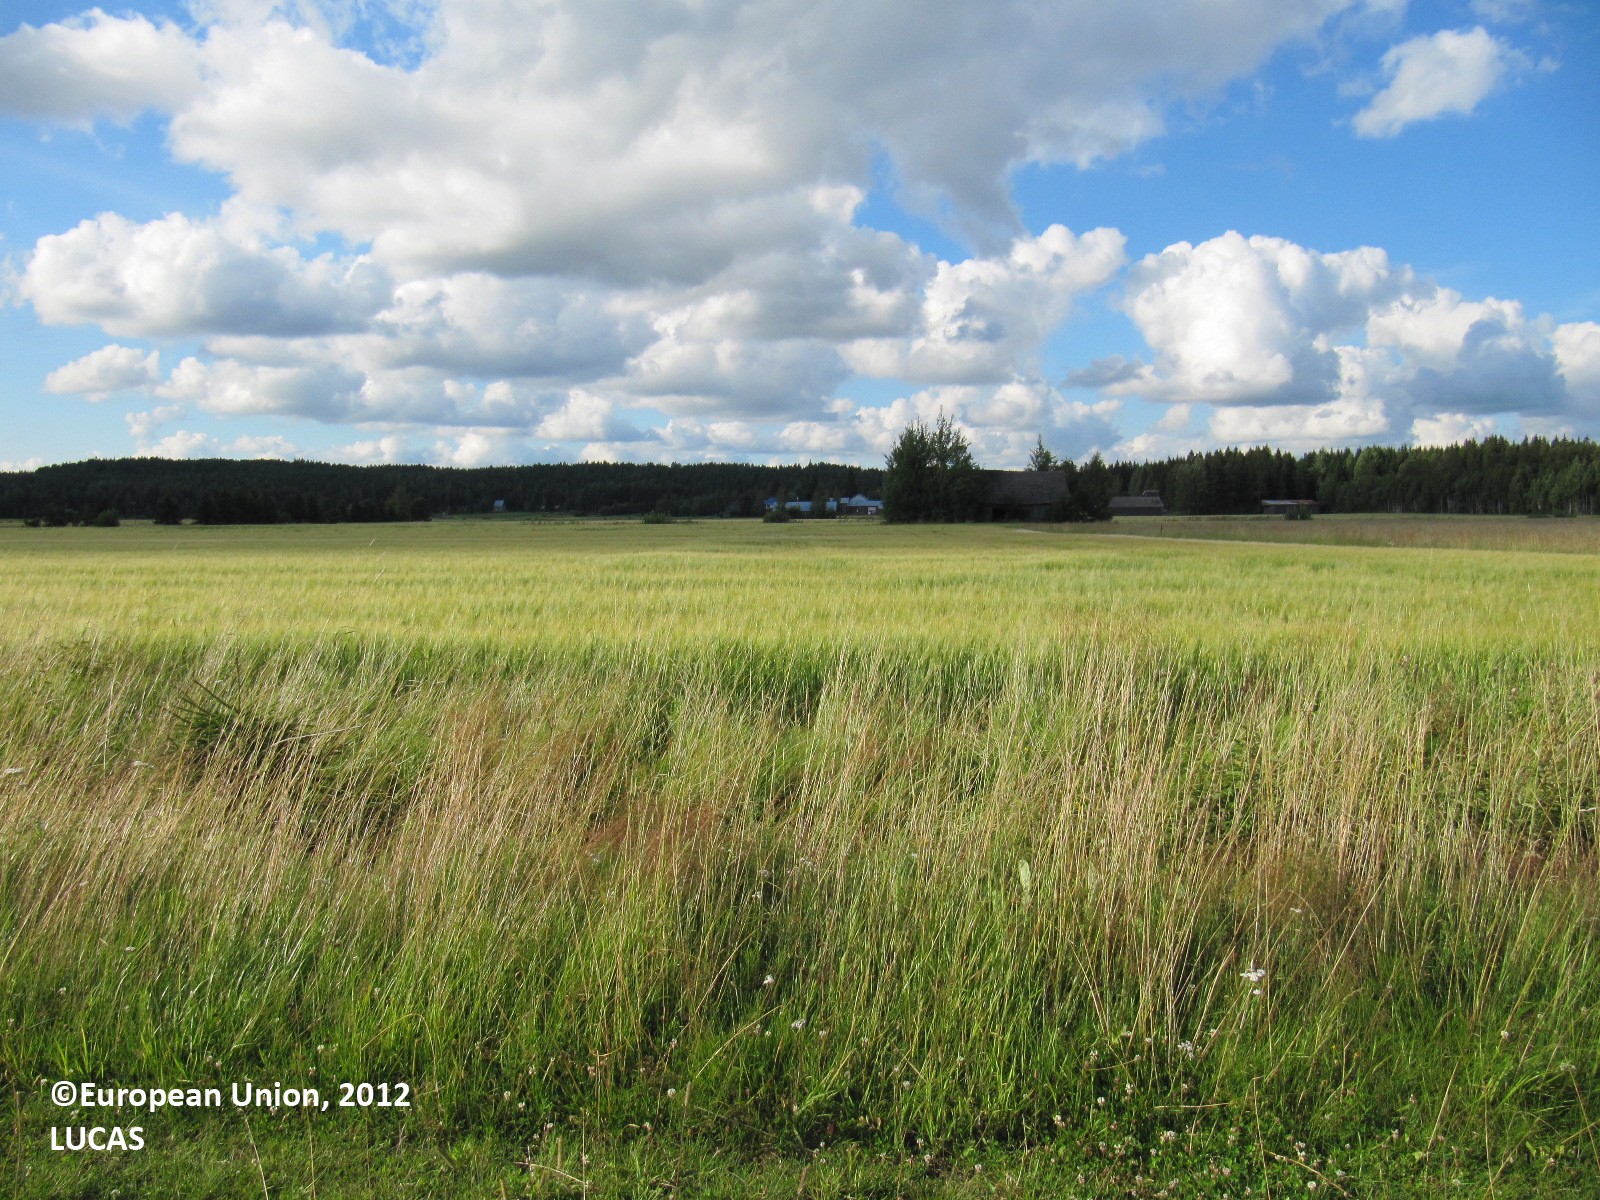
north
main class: Cropland
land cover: Barley
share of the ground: > 75 %
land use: Agriculture (excluding fallow land and kitchen gardens)
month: July
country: FI
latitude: 60.4431
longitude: 23.1108
